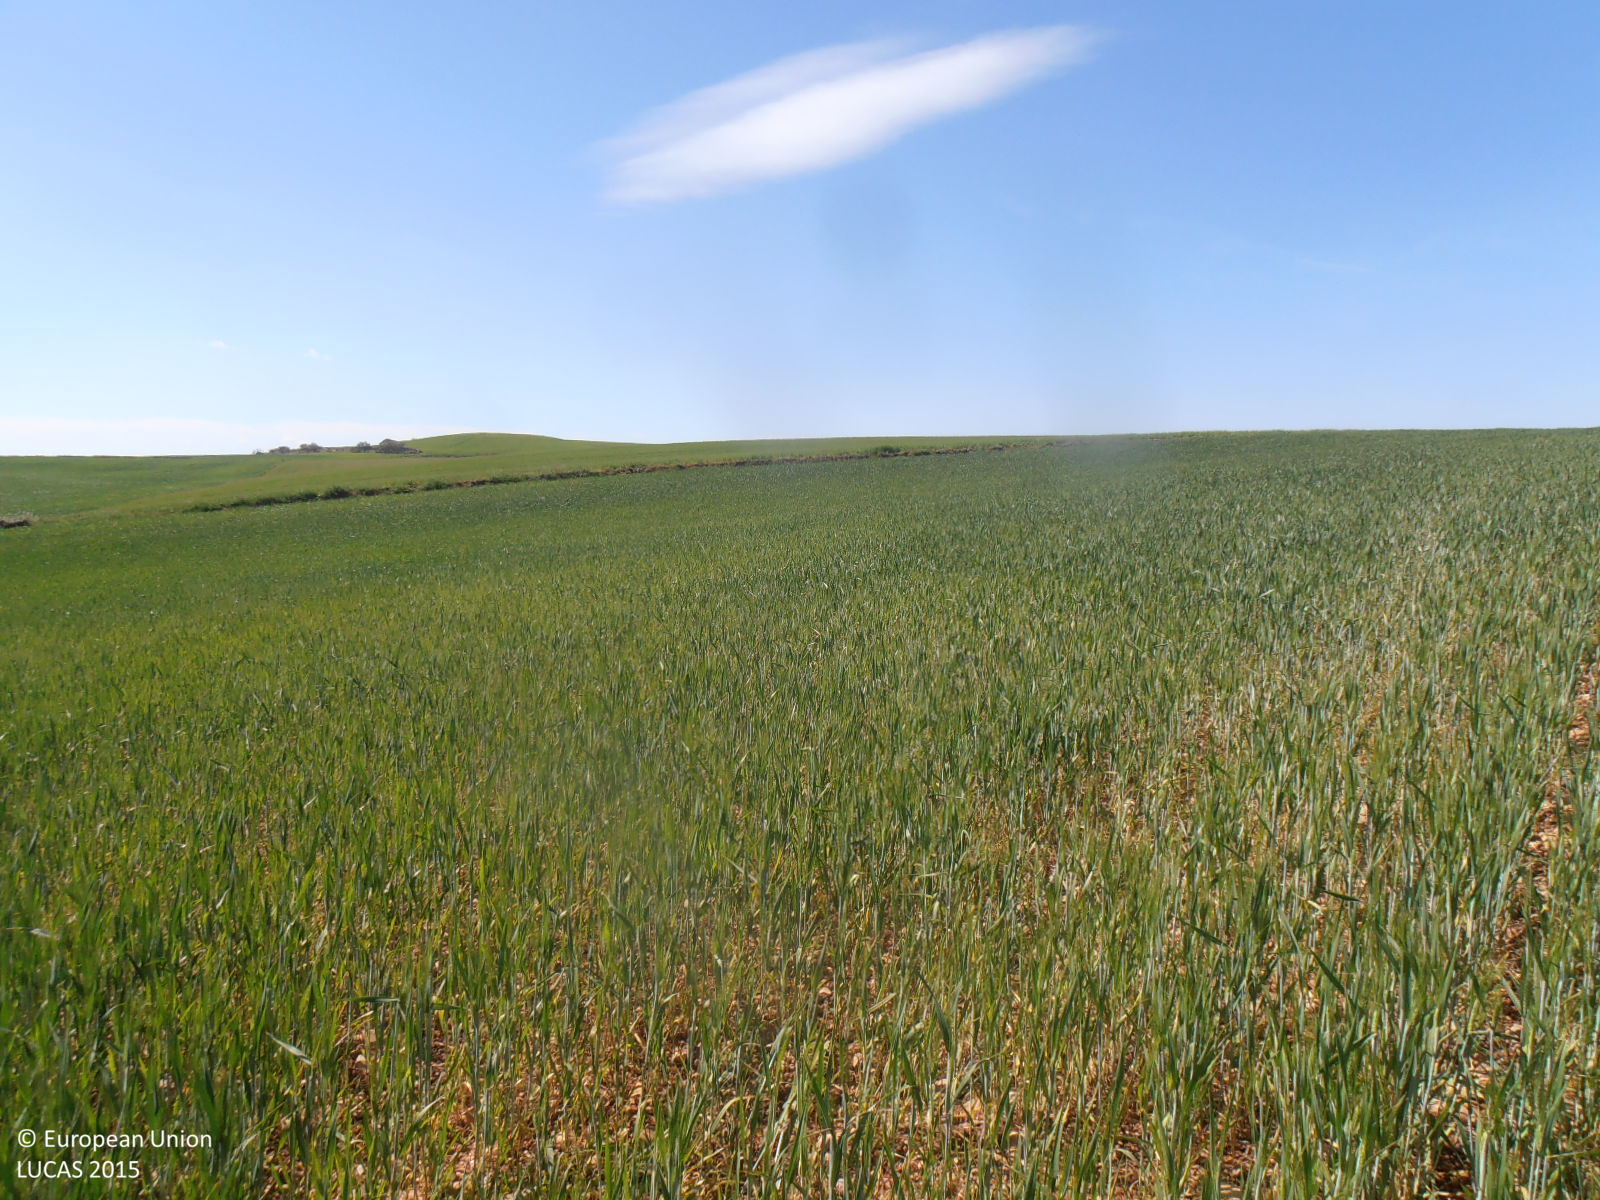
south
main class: Cropland
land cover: Durum wheat
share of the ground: > 75 %
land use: Agriculture (excluding fallow land and kitchen gardens)
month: April
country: ES
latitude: 41.3086
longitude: -1.1408
